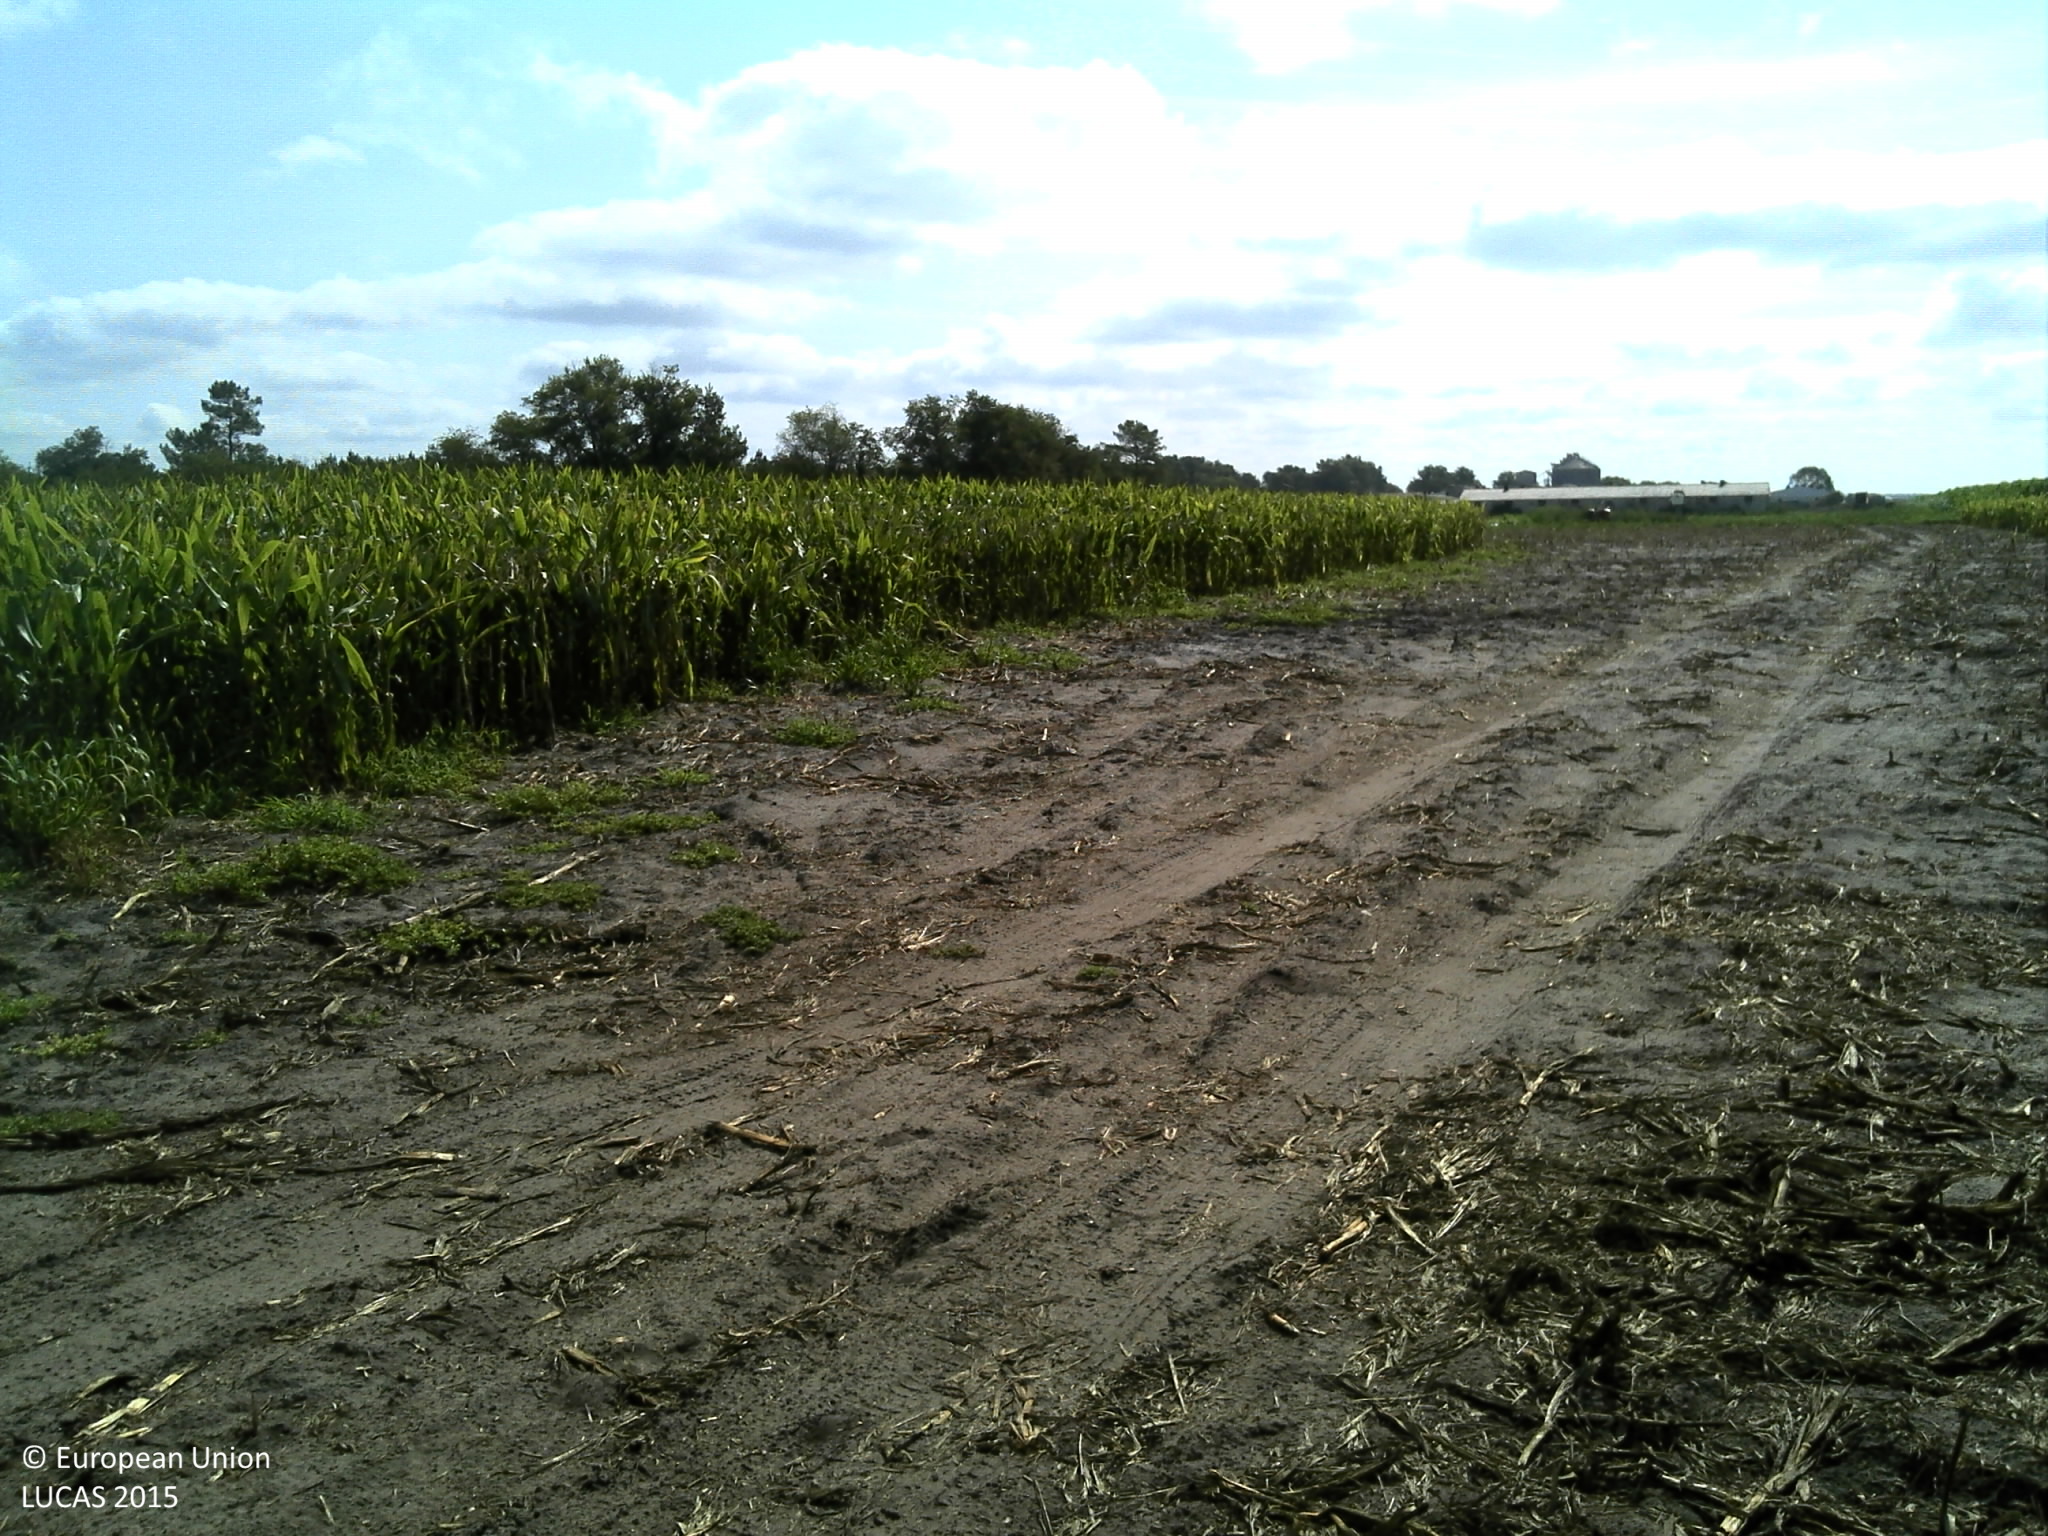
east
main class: Cropland
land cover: Maize
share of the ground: > 75 %
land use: Agriculture (excluding fallow land and kitchen gardens)
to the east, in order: Maize; Tracks; Temporary grasslands
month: August
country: FR
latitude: 44.3752
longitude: -0.5451
